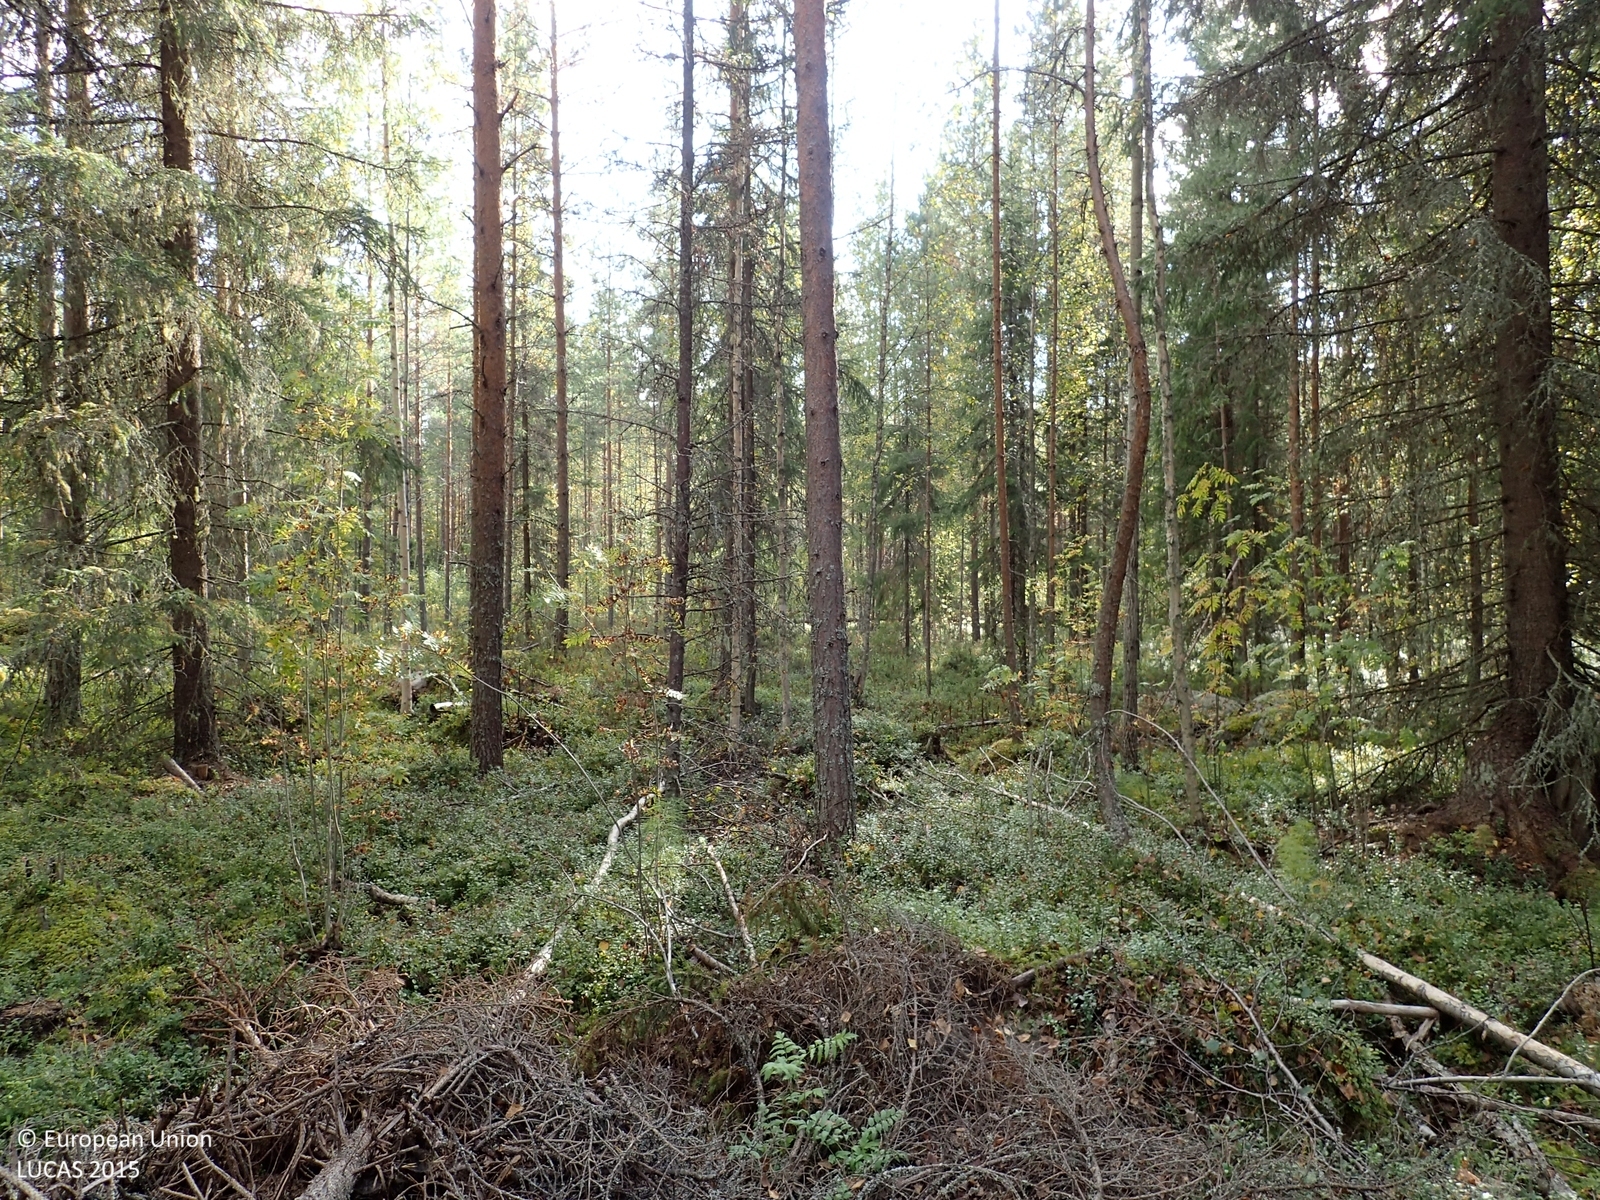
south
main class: Woodland
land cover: Other mixed woodland
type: boreal forest
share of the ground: > 75 %
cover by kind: coniferous forest trees 55 %, broadleaved forest trees 20 %, shrubs 15 %, lichens and mosses 10 %
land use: Forestry
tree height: > 5 m
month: September
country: FI
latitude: 63.0283
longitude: 25.4207
